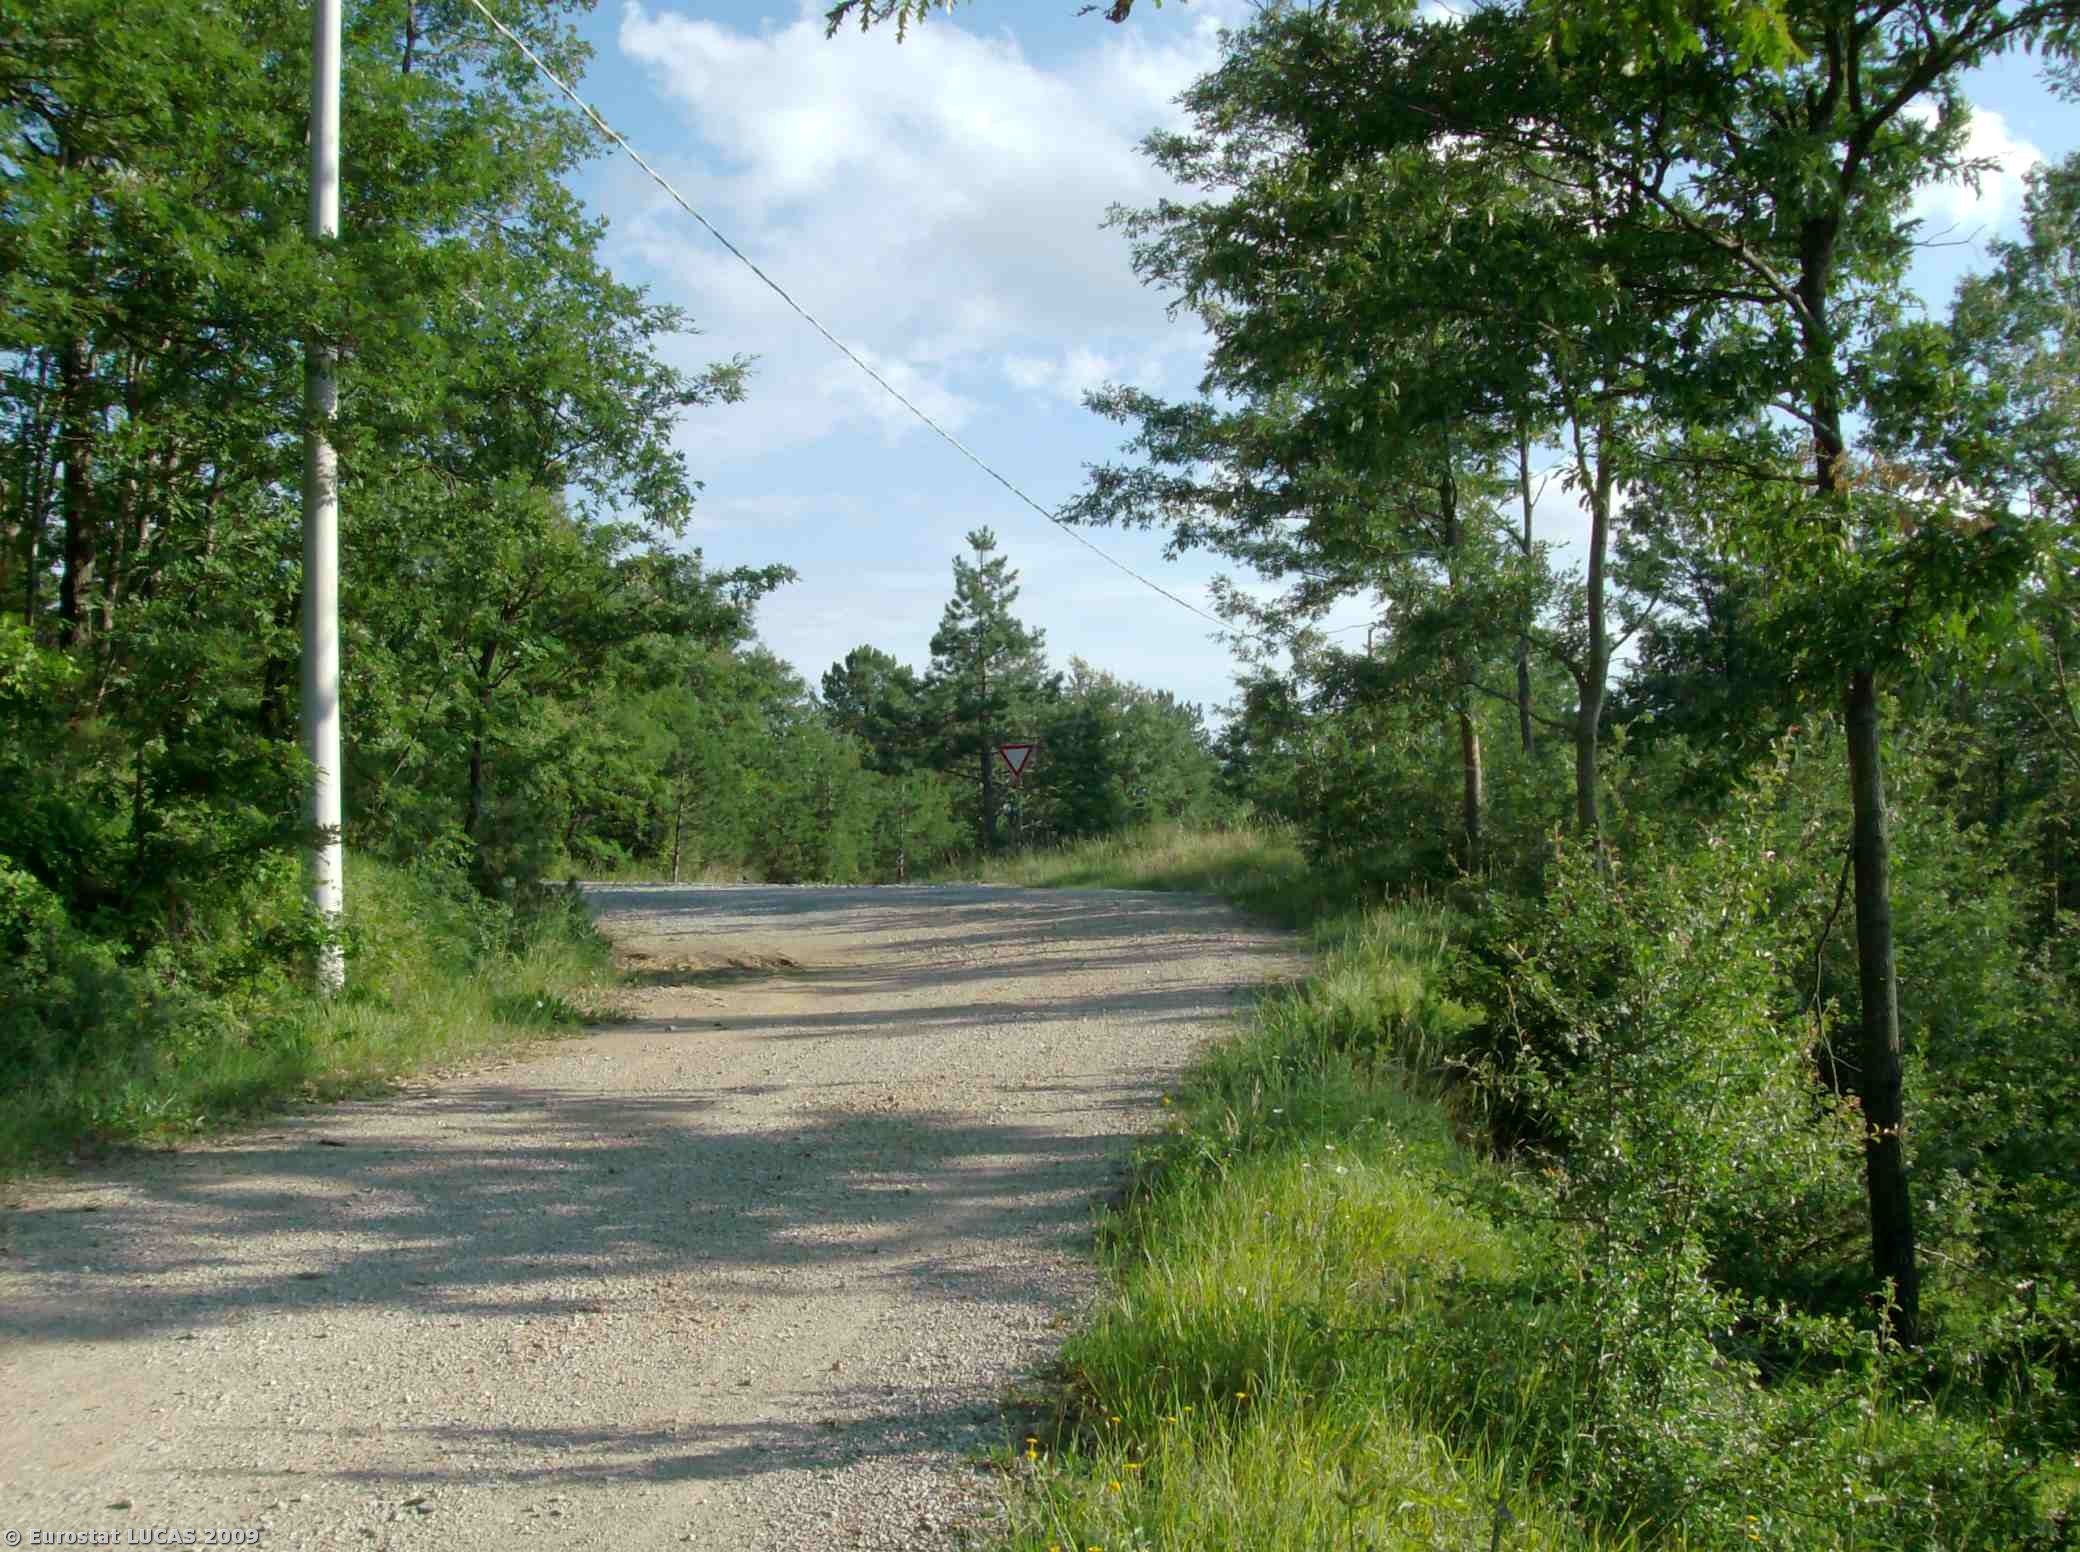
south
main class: Woodland
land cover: Mixed woodland
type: coniferous forest of the mediterranean region
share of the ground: > 75 %
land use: Forestry
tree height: > 5 m
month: June
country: IT
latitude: 42.7856
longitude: 11.6206
